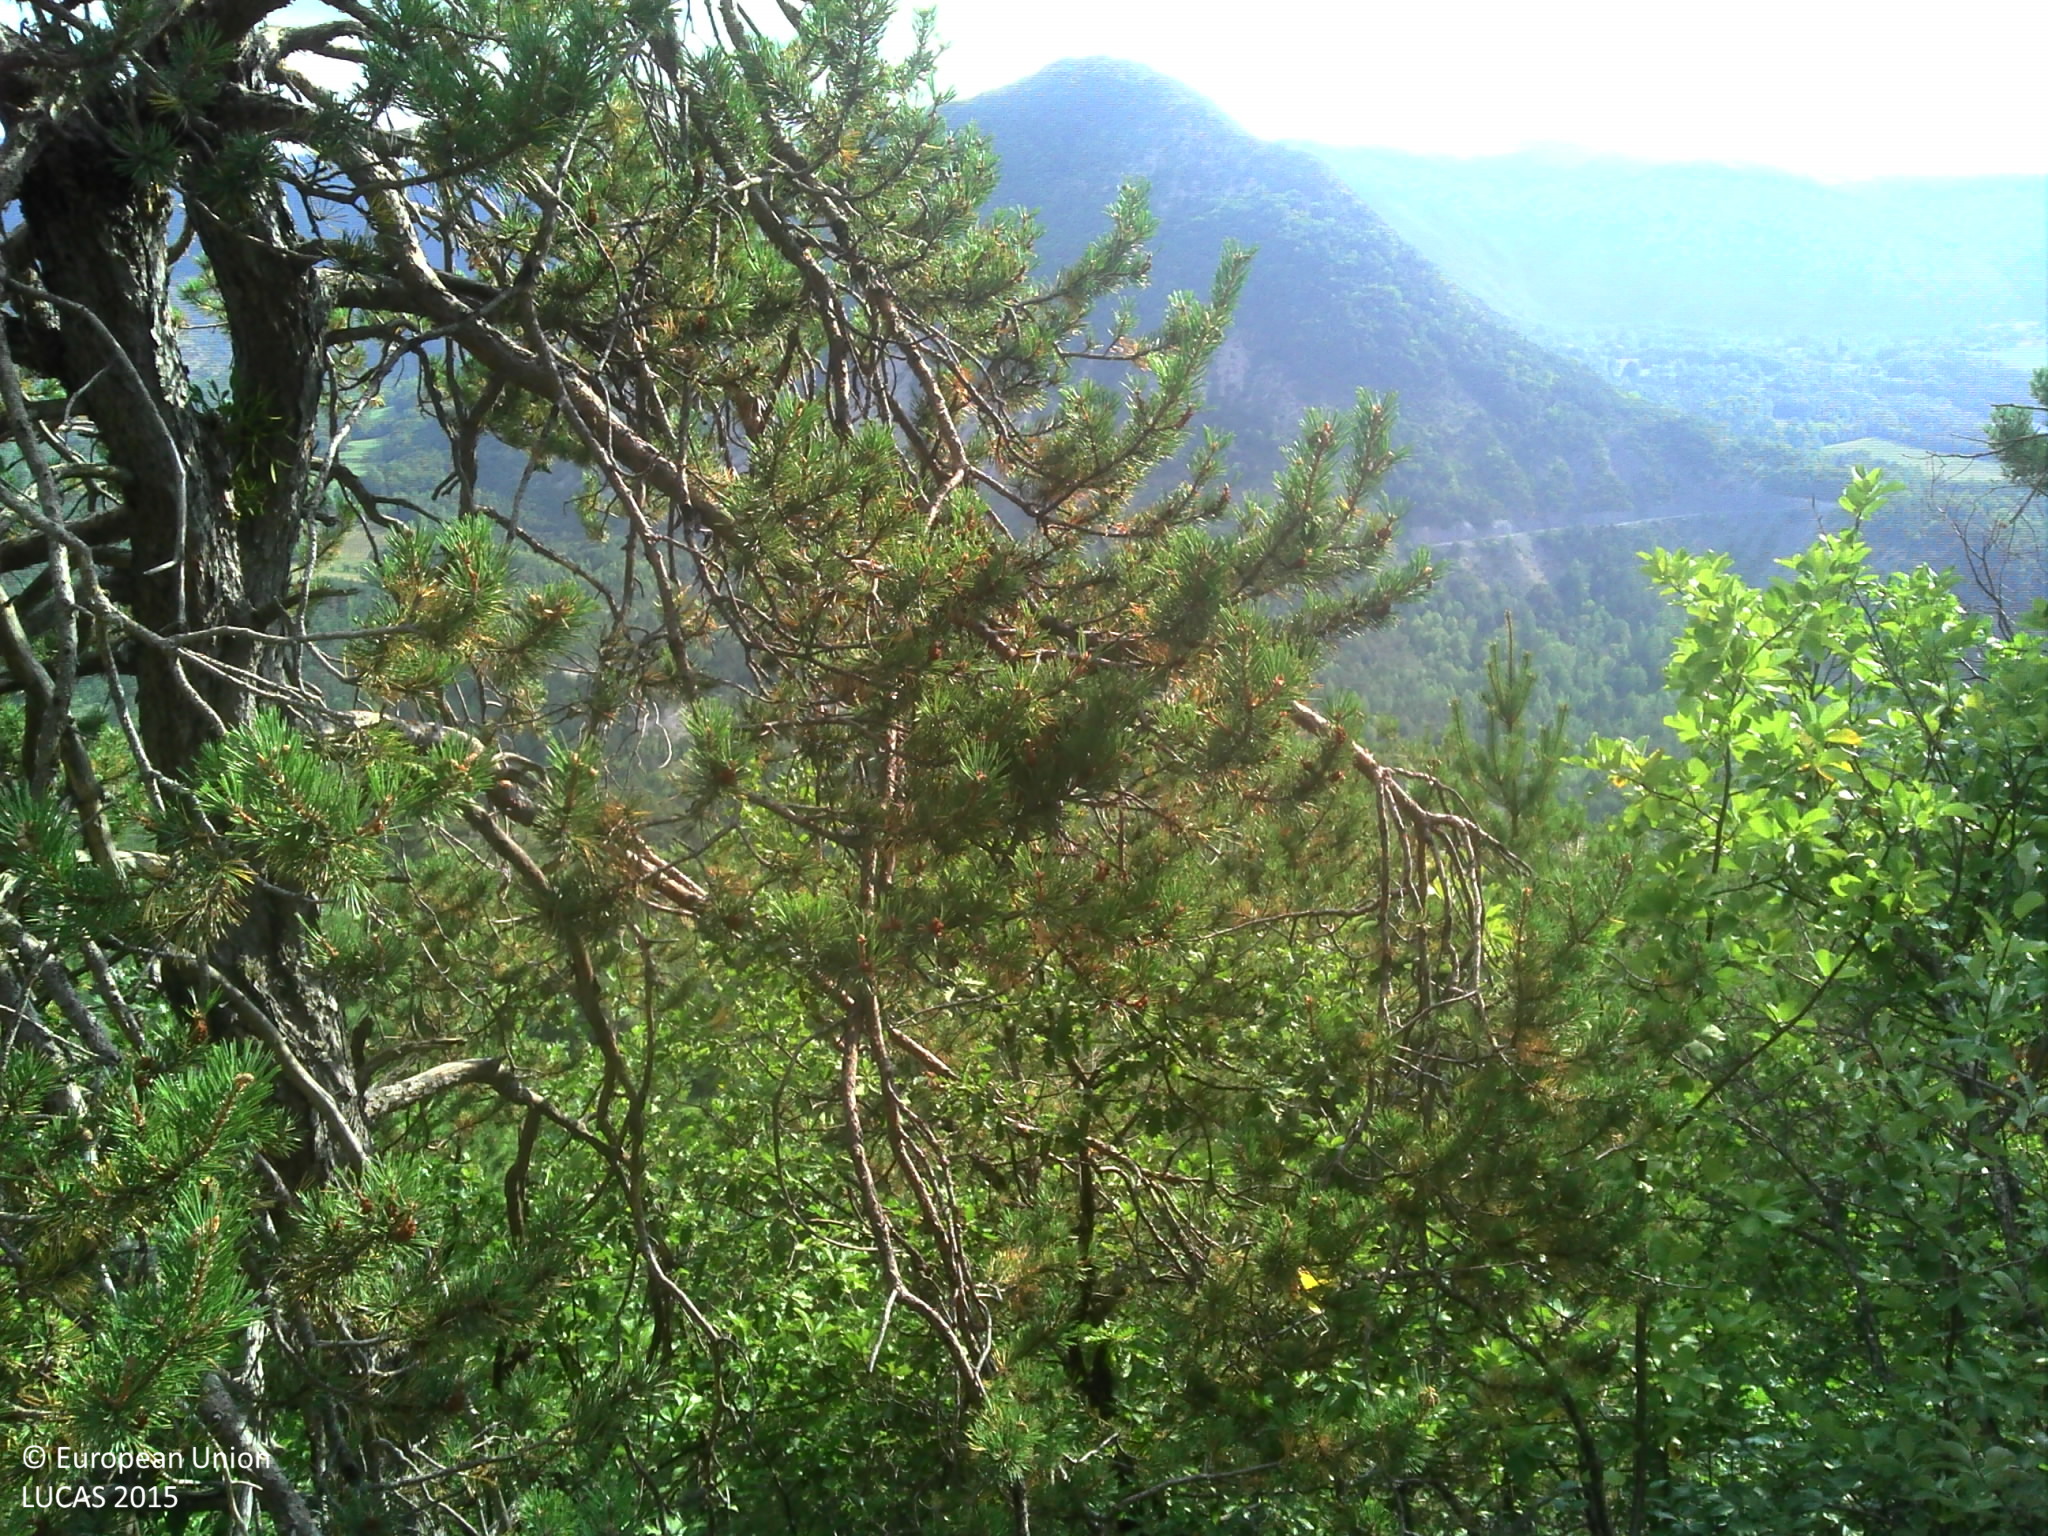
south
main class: Shrubland
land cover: Shrubland with sparse tree cover
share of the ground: 50 - 75 %
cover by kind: shrubs 50 %, herbaceous plants 20 %, consolidated bare surface 15 %, unconsolidated bare surface 10 %, broadleaved forest trees 5 %
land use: Semi-natural and natural areas not in use
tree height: < 5 m
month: August
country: FR
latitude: 44.3922
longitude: 6.2783
